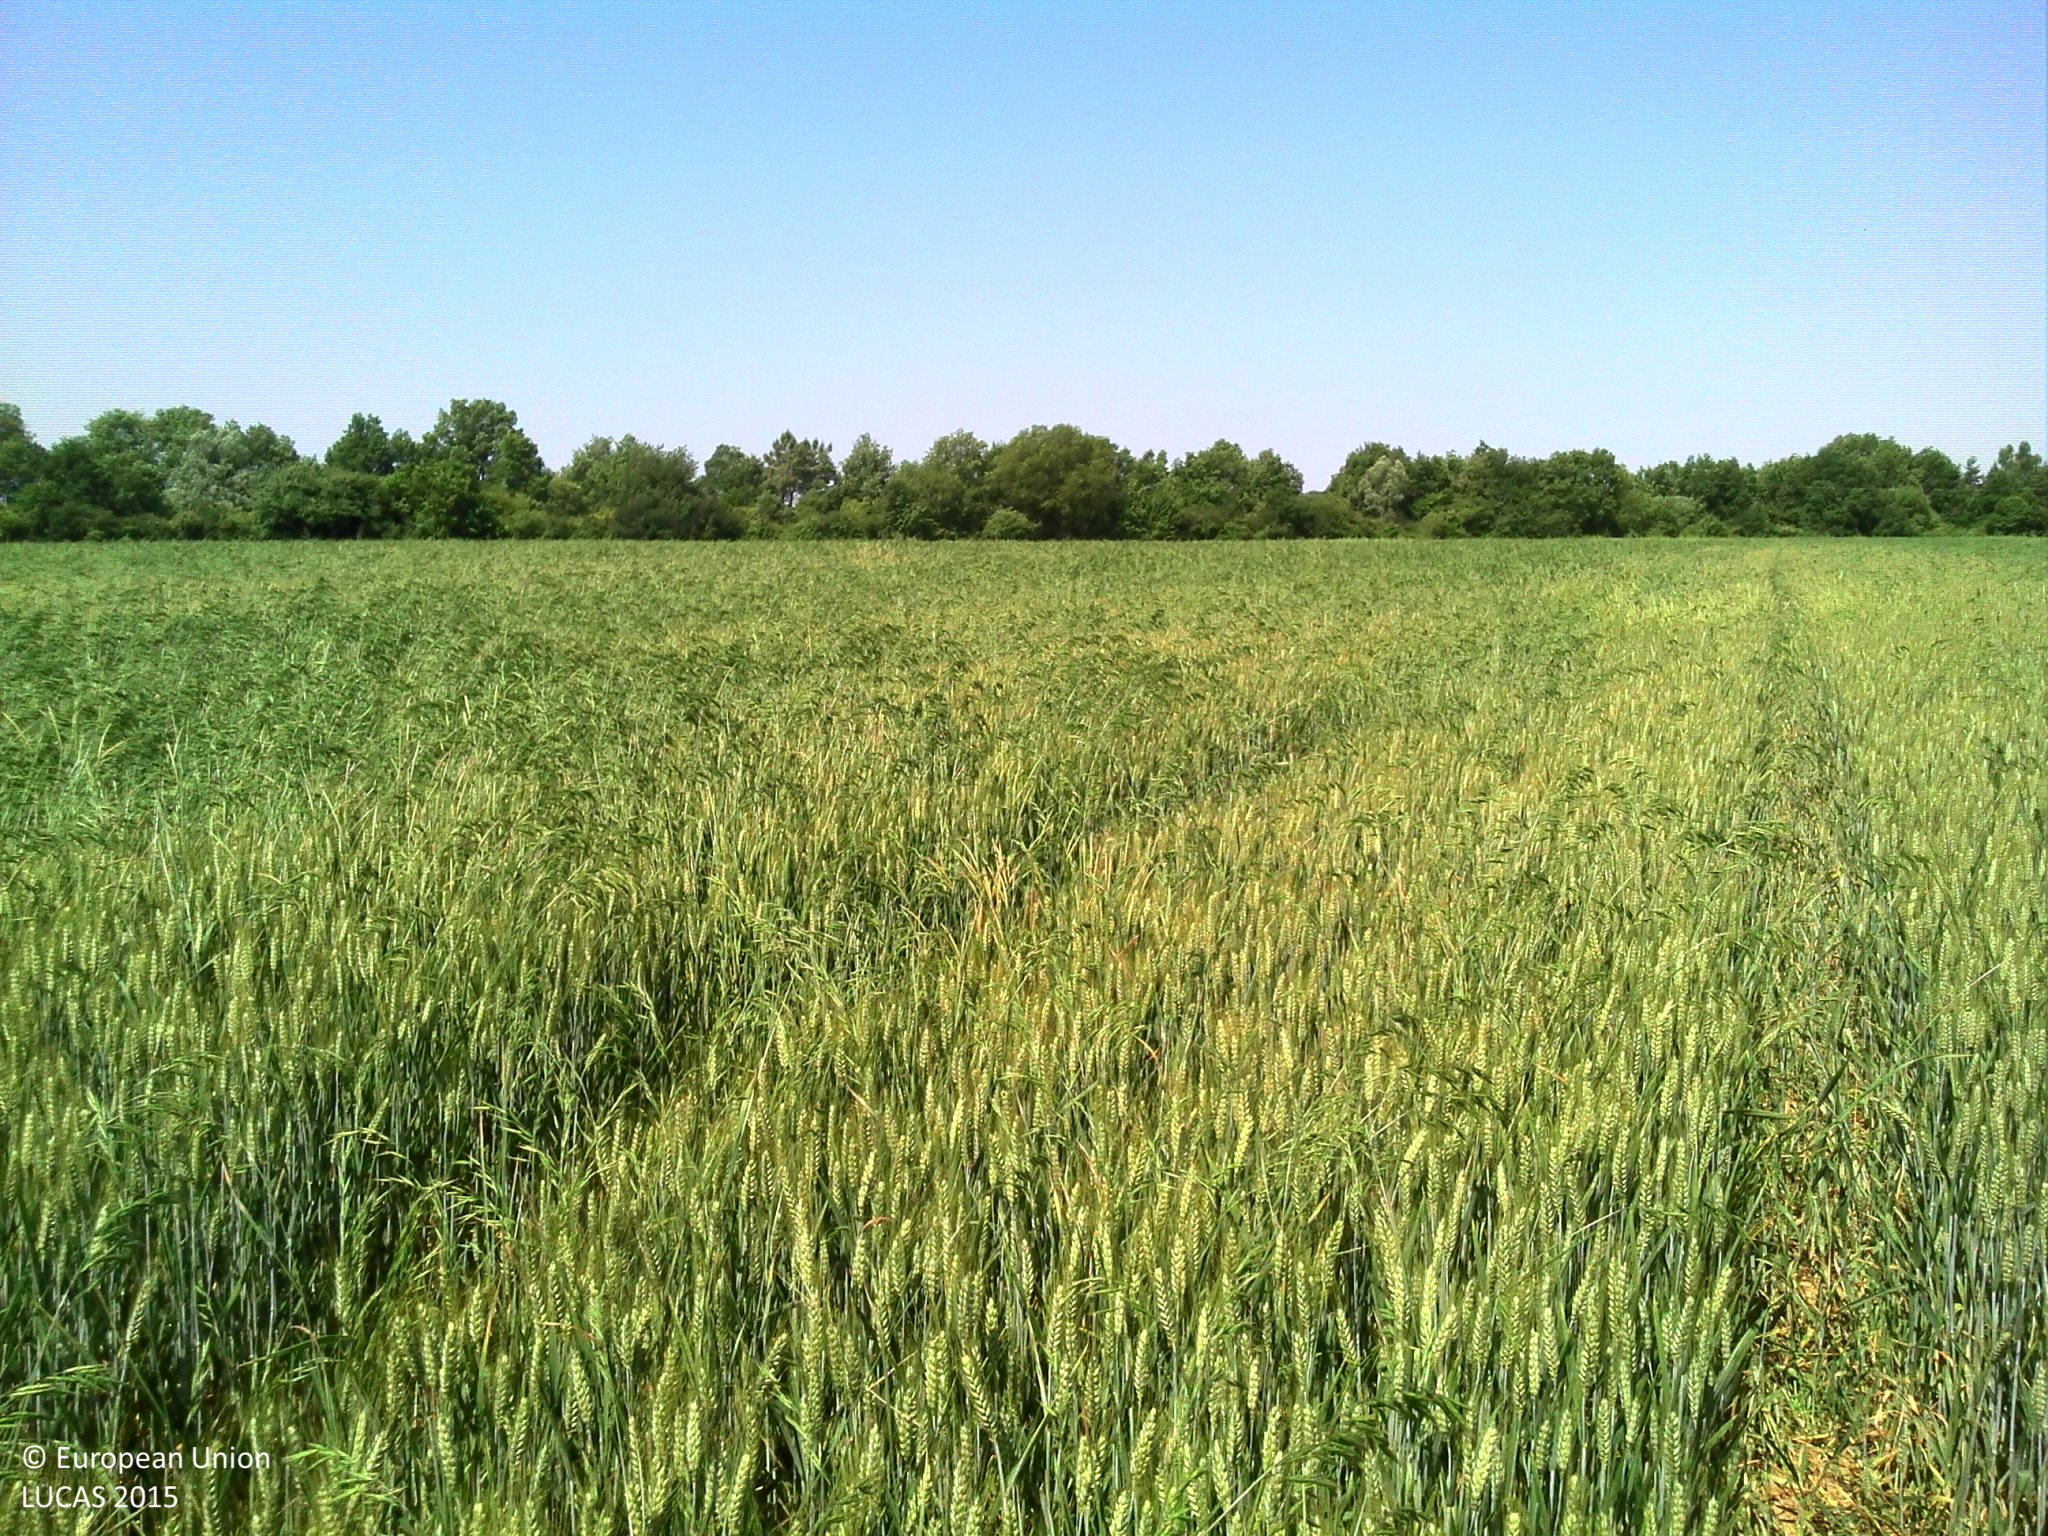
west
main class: Cropland
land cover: Common wheat
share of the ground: > 75 %
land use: Agriculture (excluding fallow land and kitchen gardens)
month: June
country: FR
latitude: 46.7742
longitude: 0.6450
